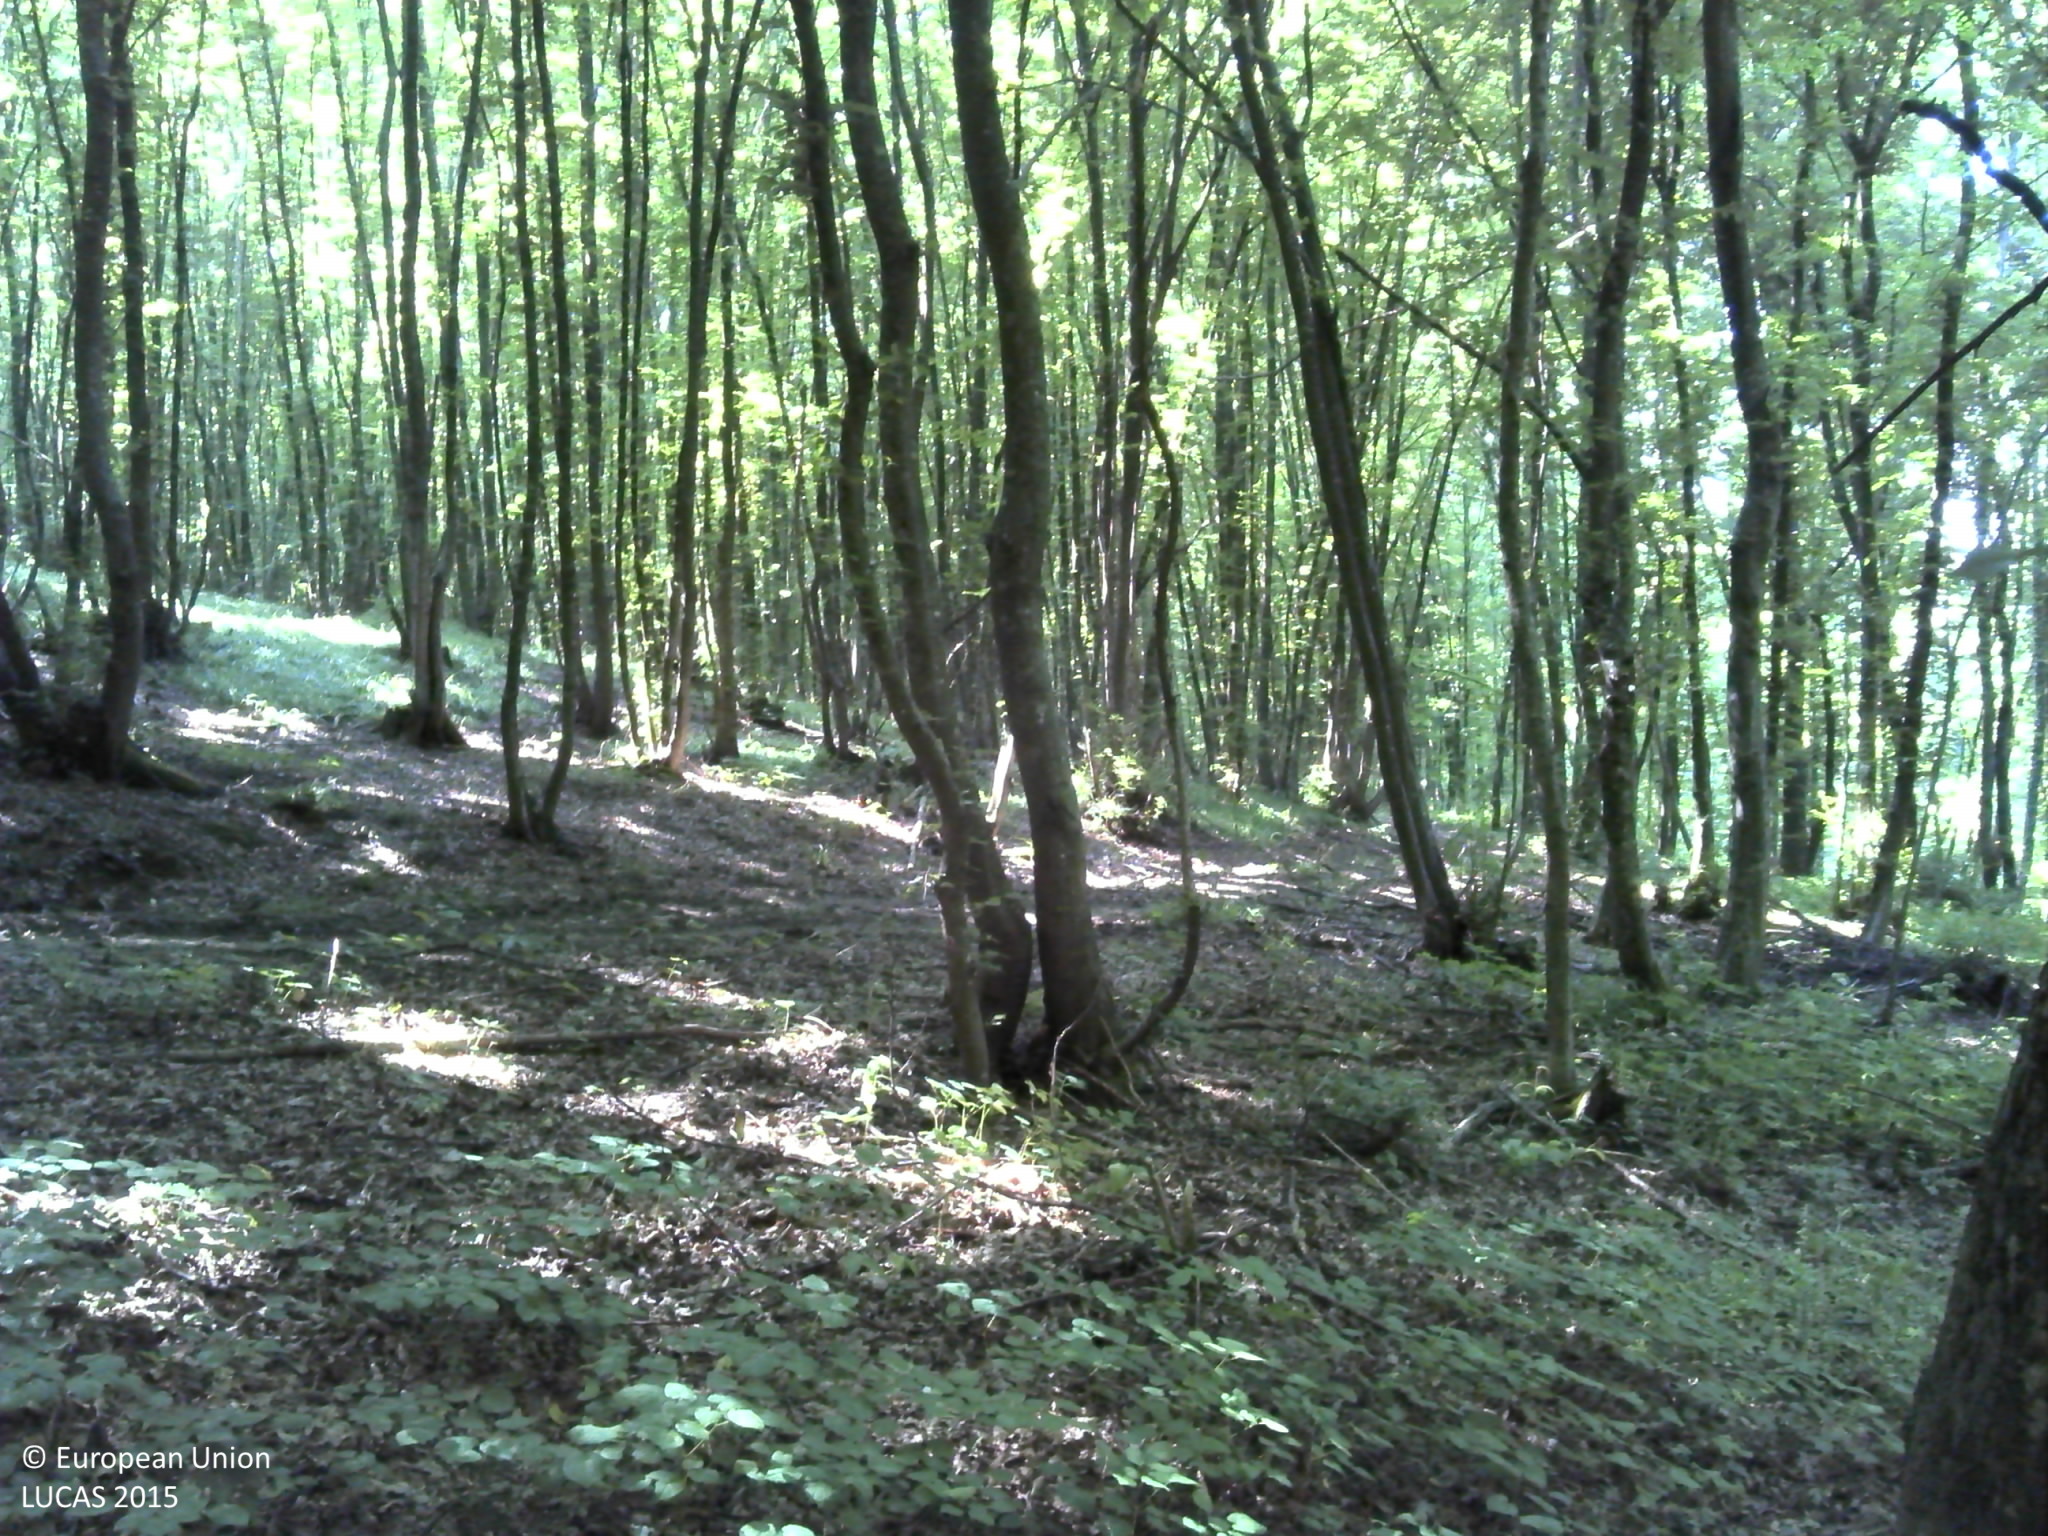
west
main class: Woodland
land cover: Broadleaved woodland
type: beech forest
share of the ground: > 75 %
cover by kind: broadleaved forest trees 80 %, lichens and mosses 20 %
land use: Forestry
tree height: > 5 m
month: June
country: HR
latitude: 45.3714
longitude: 17.6500
